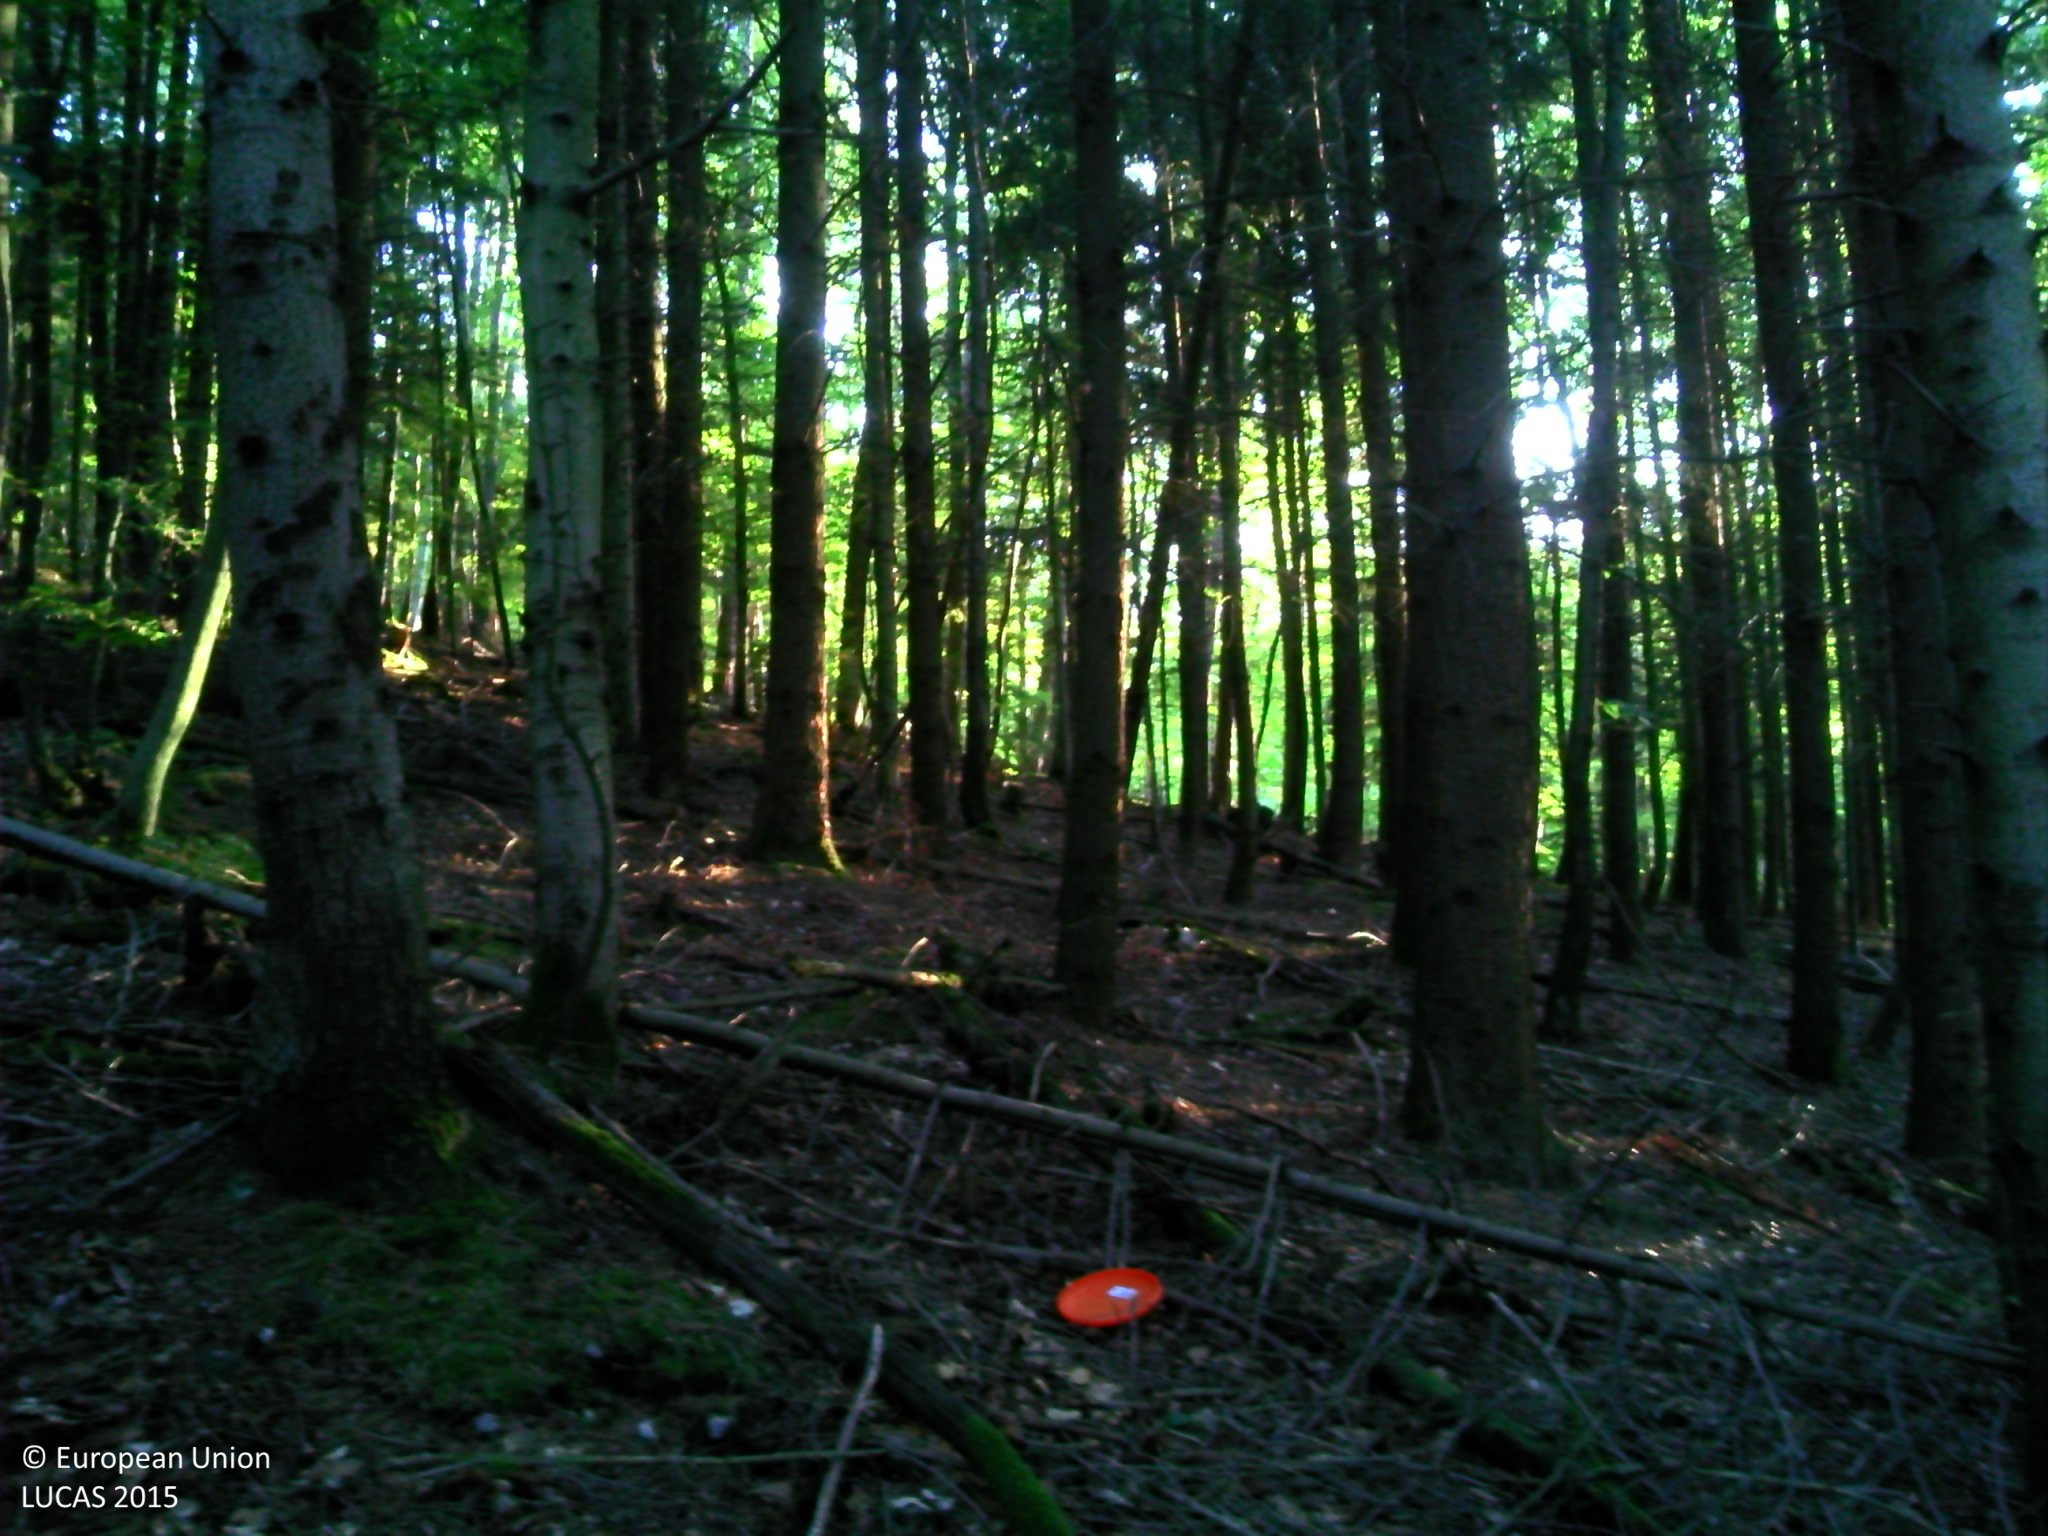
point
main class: Woodland
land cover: Spruce dominated coniferous woodland
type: hemiboreal forest and nemoral coniferous forest and mixed broadleaved-coniferous forest
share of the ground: > 75 %
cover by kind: coniferous forest trees 90 %, broadleaved forest trees 10 %
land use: Forestry
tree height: > 5 m
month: August
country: FR
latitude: 48.3536
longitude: 7.3424
